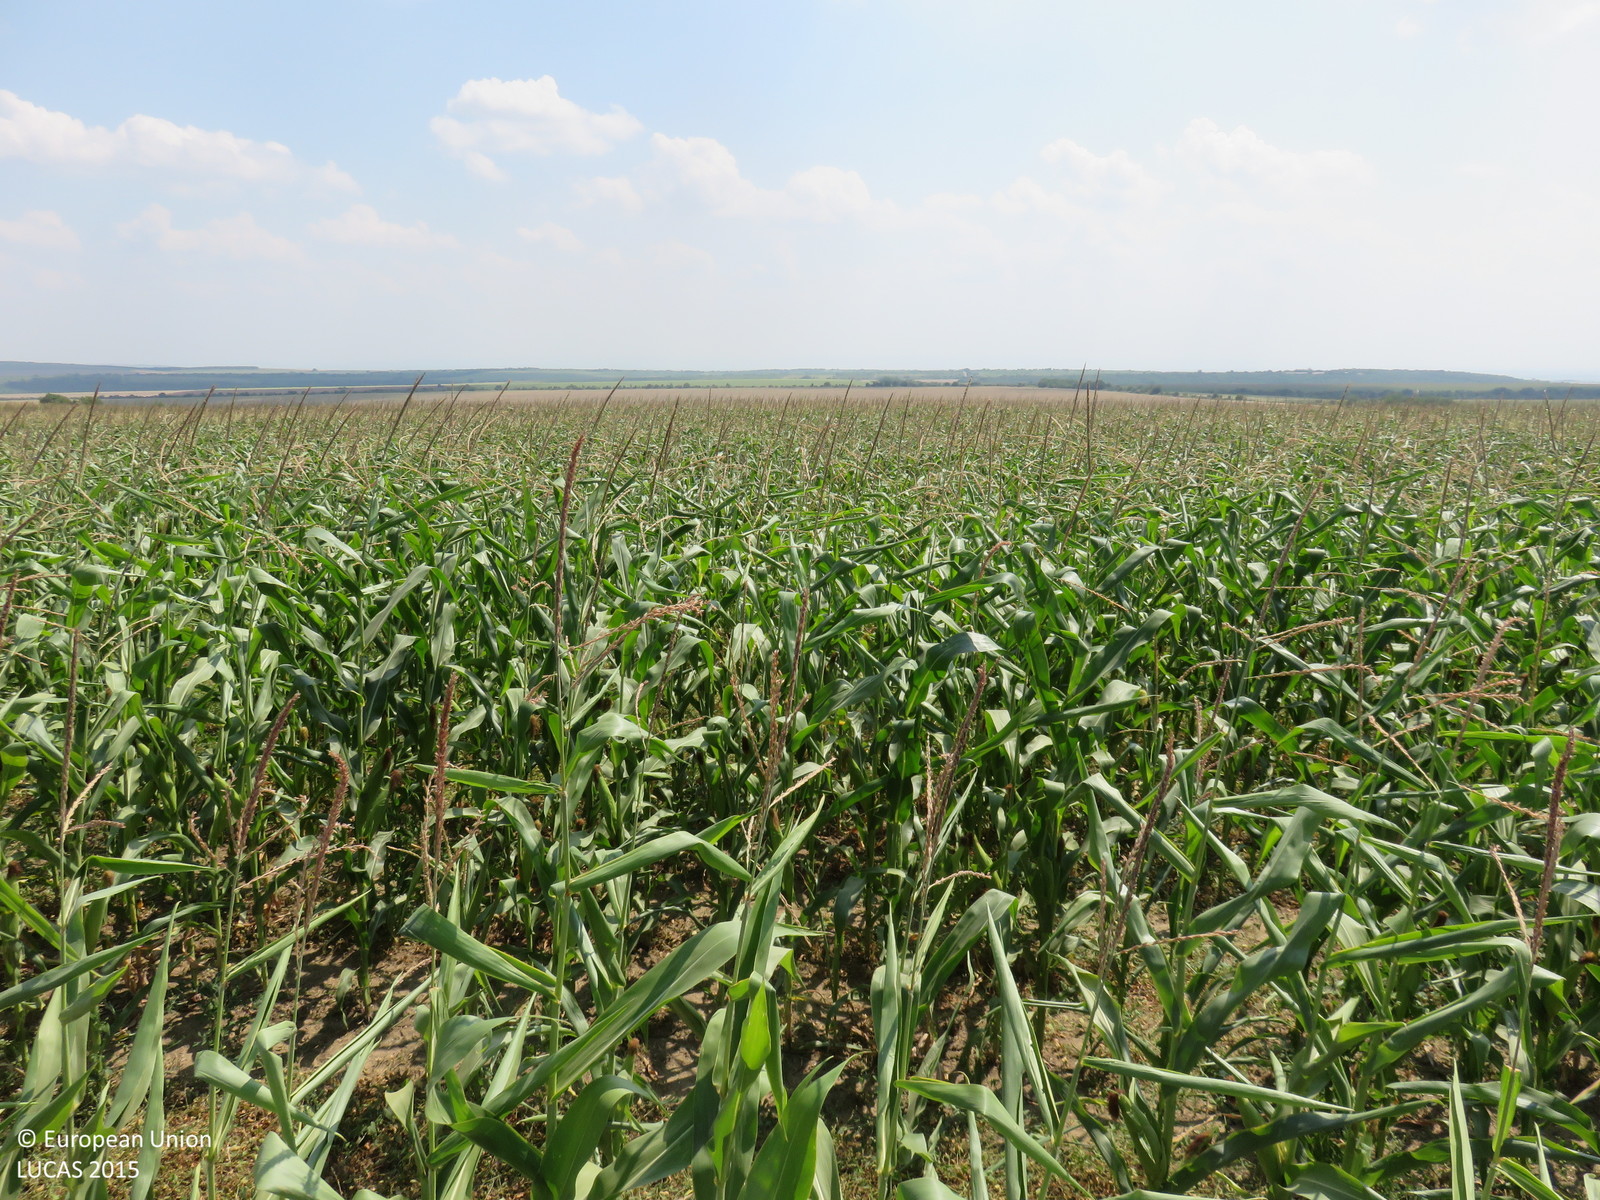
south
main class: Cropland
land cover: Maize
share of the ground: > 75 %
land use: Agriculture (excluding fallow land and kitchen gardens)
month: July
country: BG
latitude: 43.5373
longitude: 25.0590
